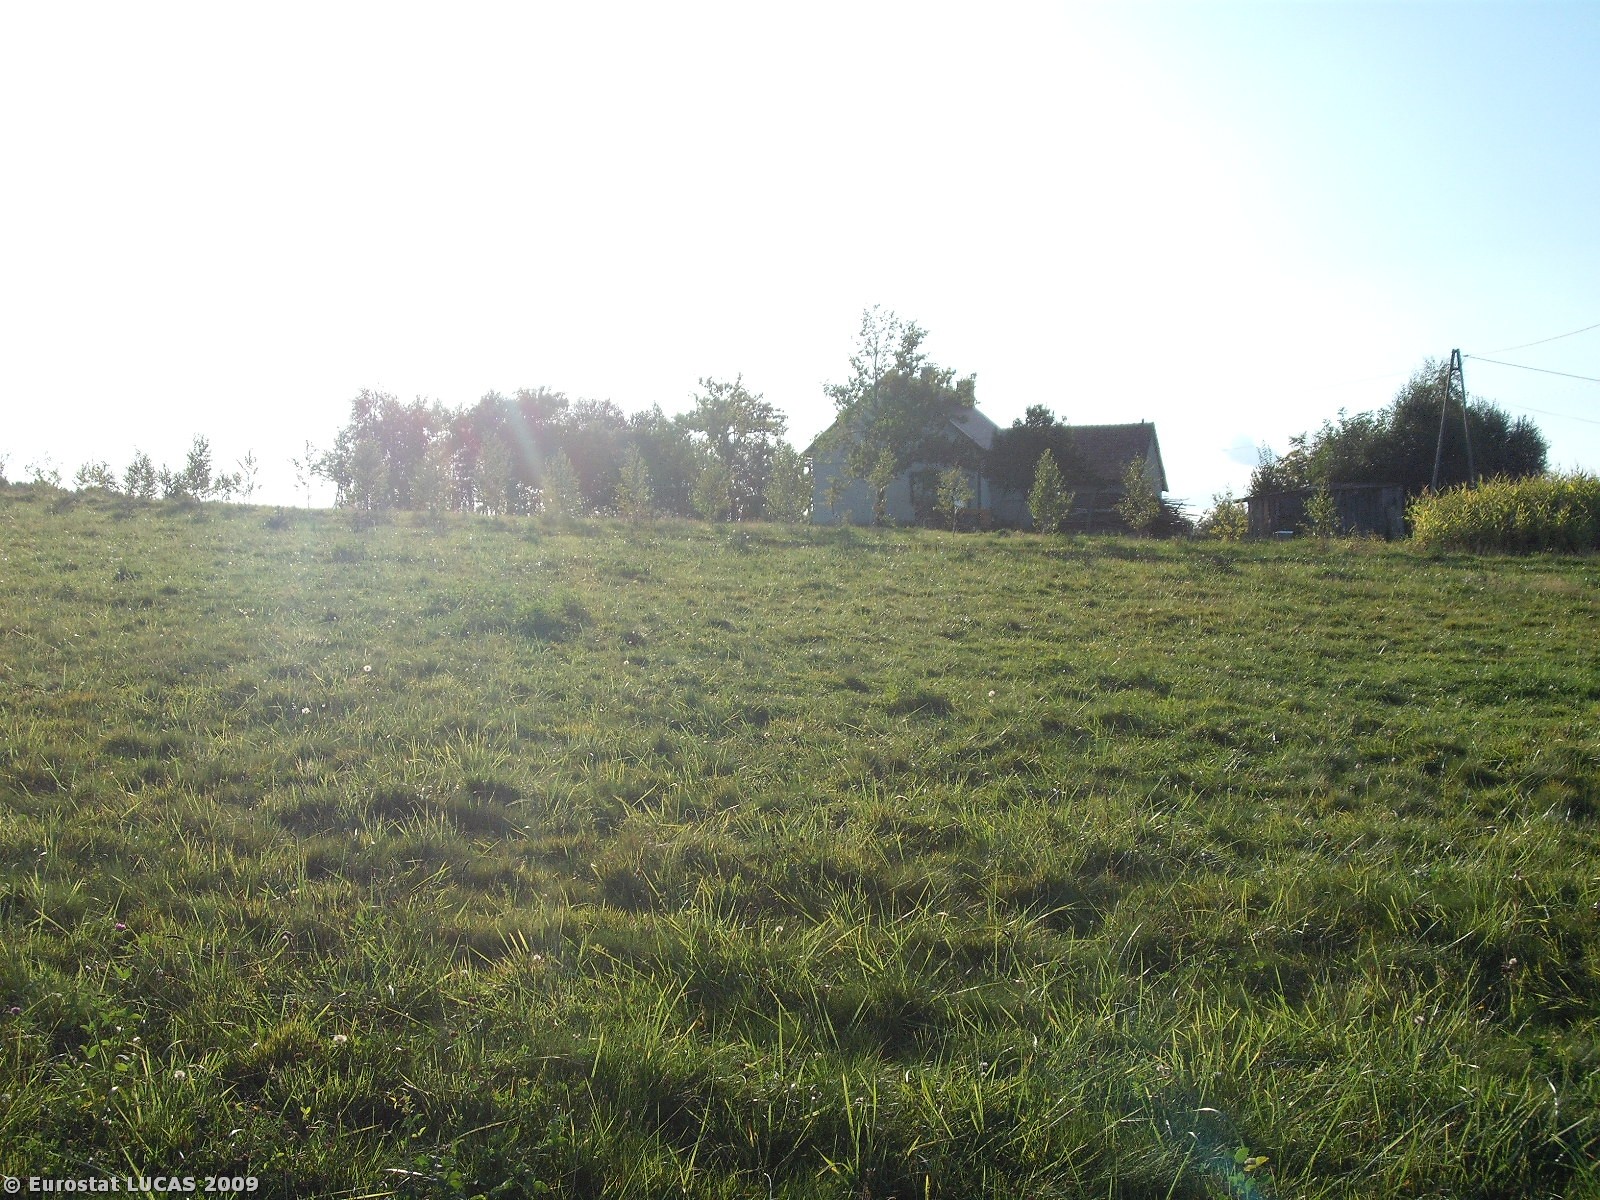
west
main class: Grassland
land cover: Grassland with sparse tree/shrub cover
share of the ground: > 75 %
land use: Agriculture (excluding fallow land and kitchen gardens)
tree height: > 5 m
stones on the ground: < 10 %
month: September
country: PL
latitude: 49.8740
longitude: 22.0100
